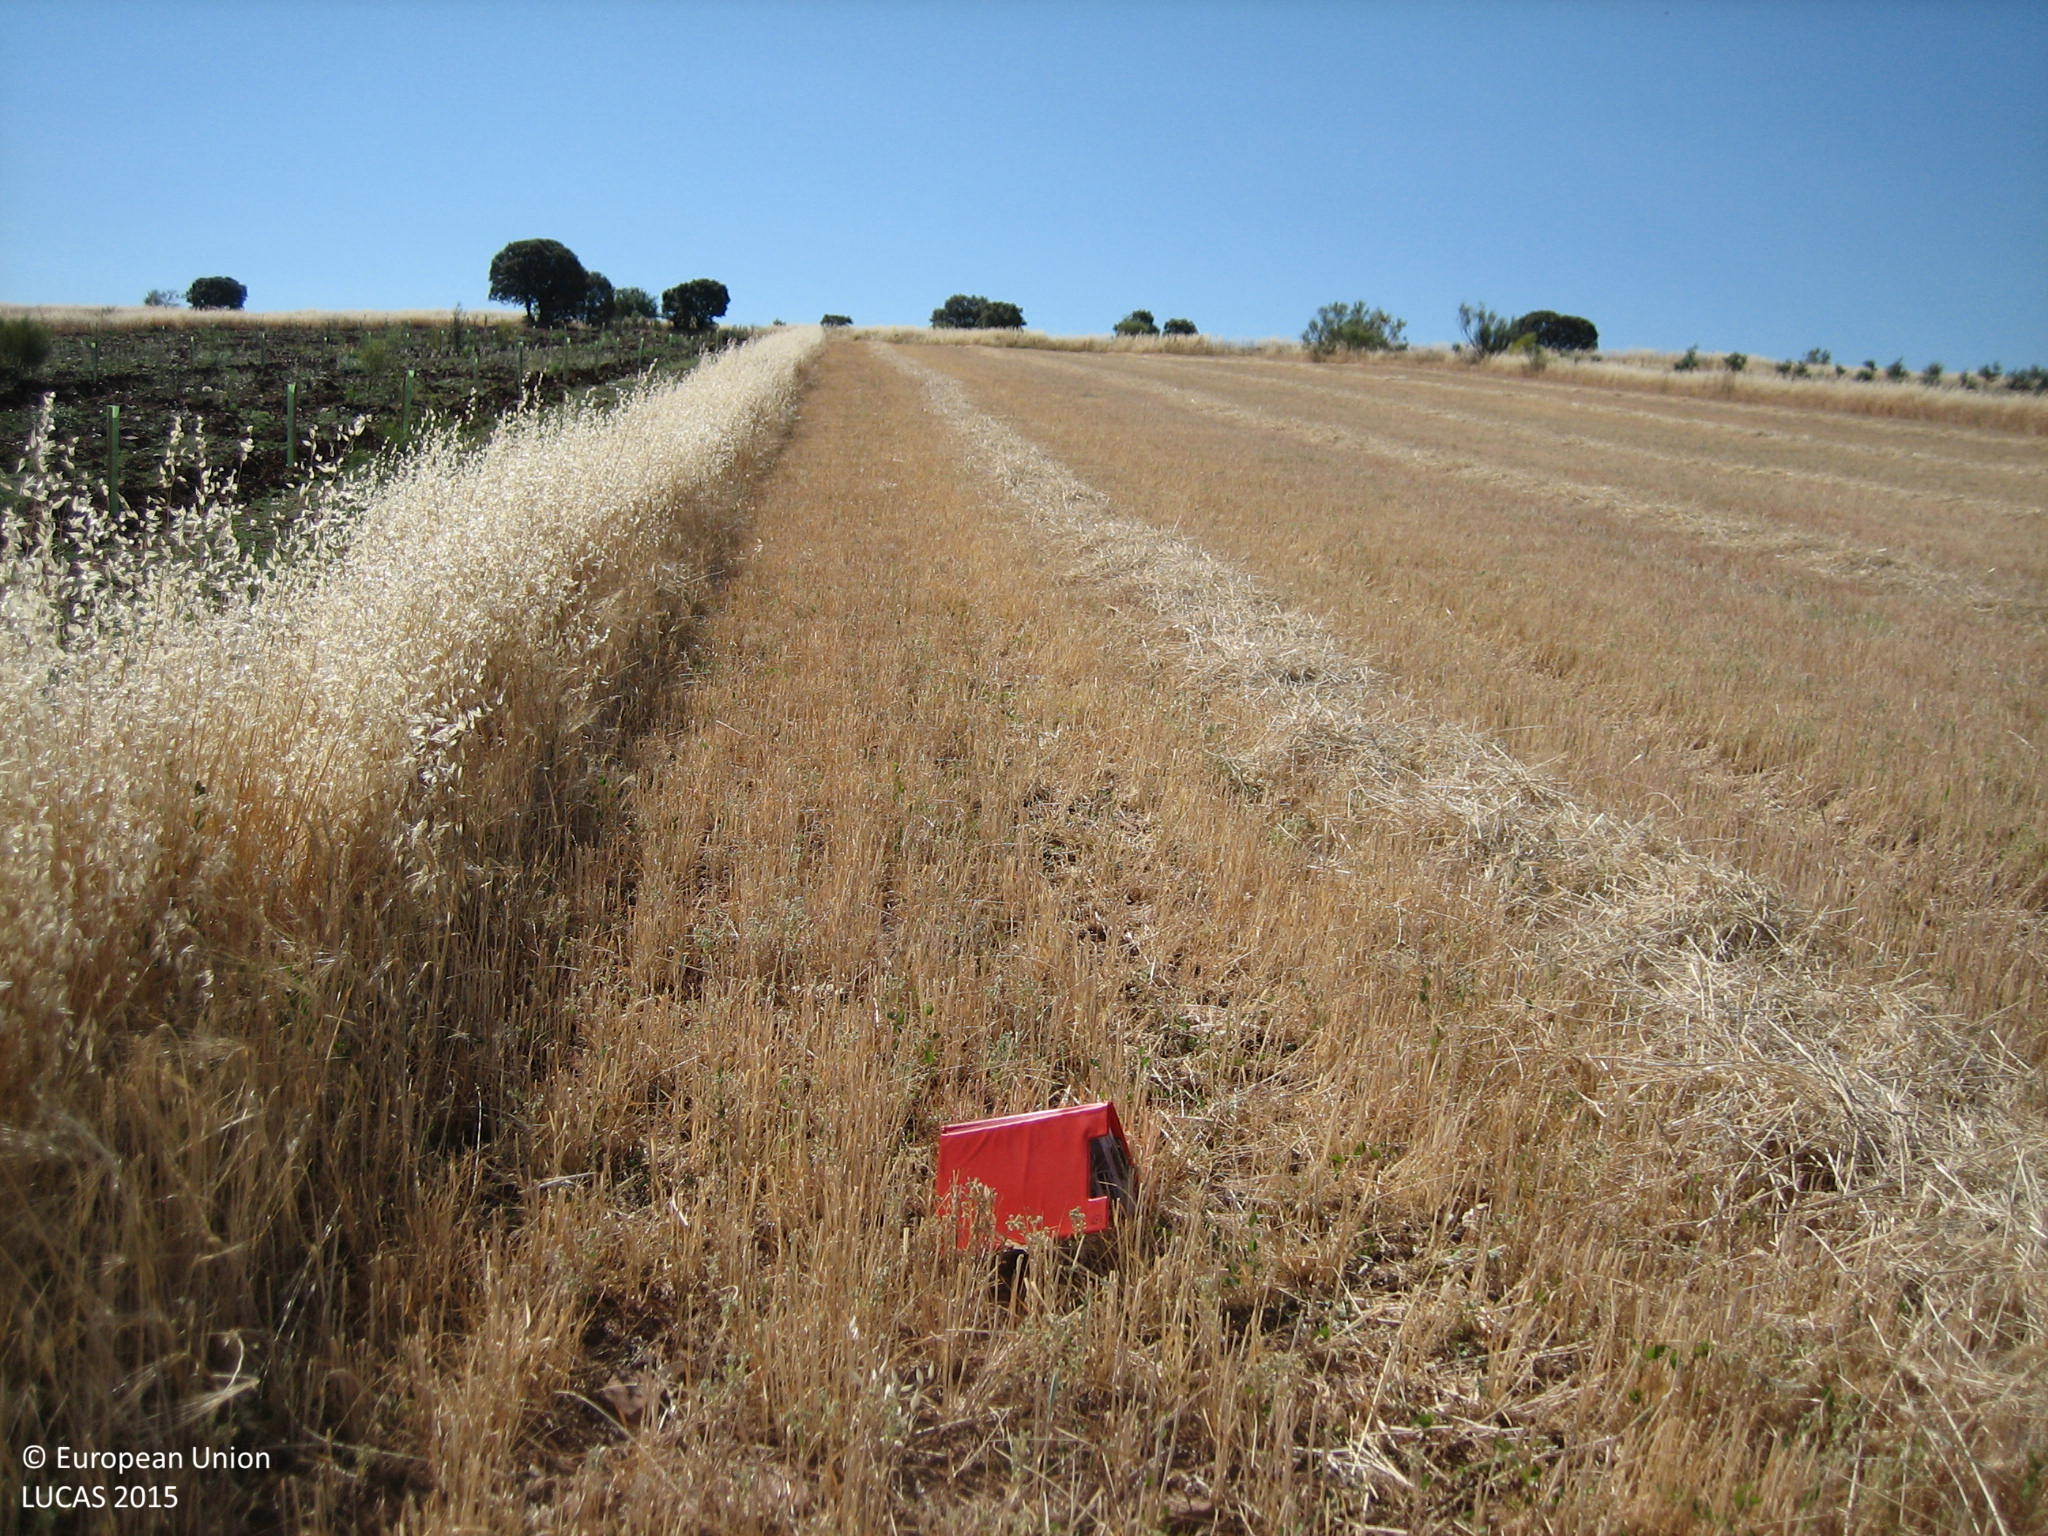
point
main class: Cropland
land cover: Common wheat
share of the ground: < 10 %
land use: Agriculture (excluding fallow land and kitchen gardens)
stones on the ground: < 10 %
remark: Harvested field
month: June
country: ES
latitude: 38.6315
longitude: -4.0194
